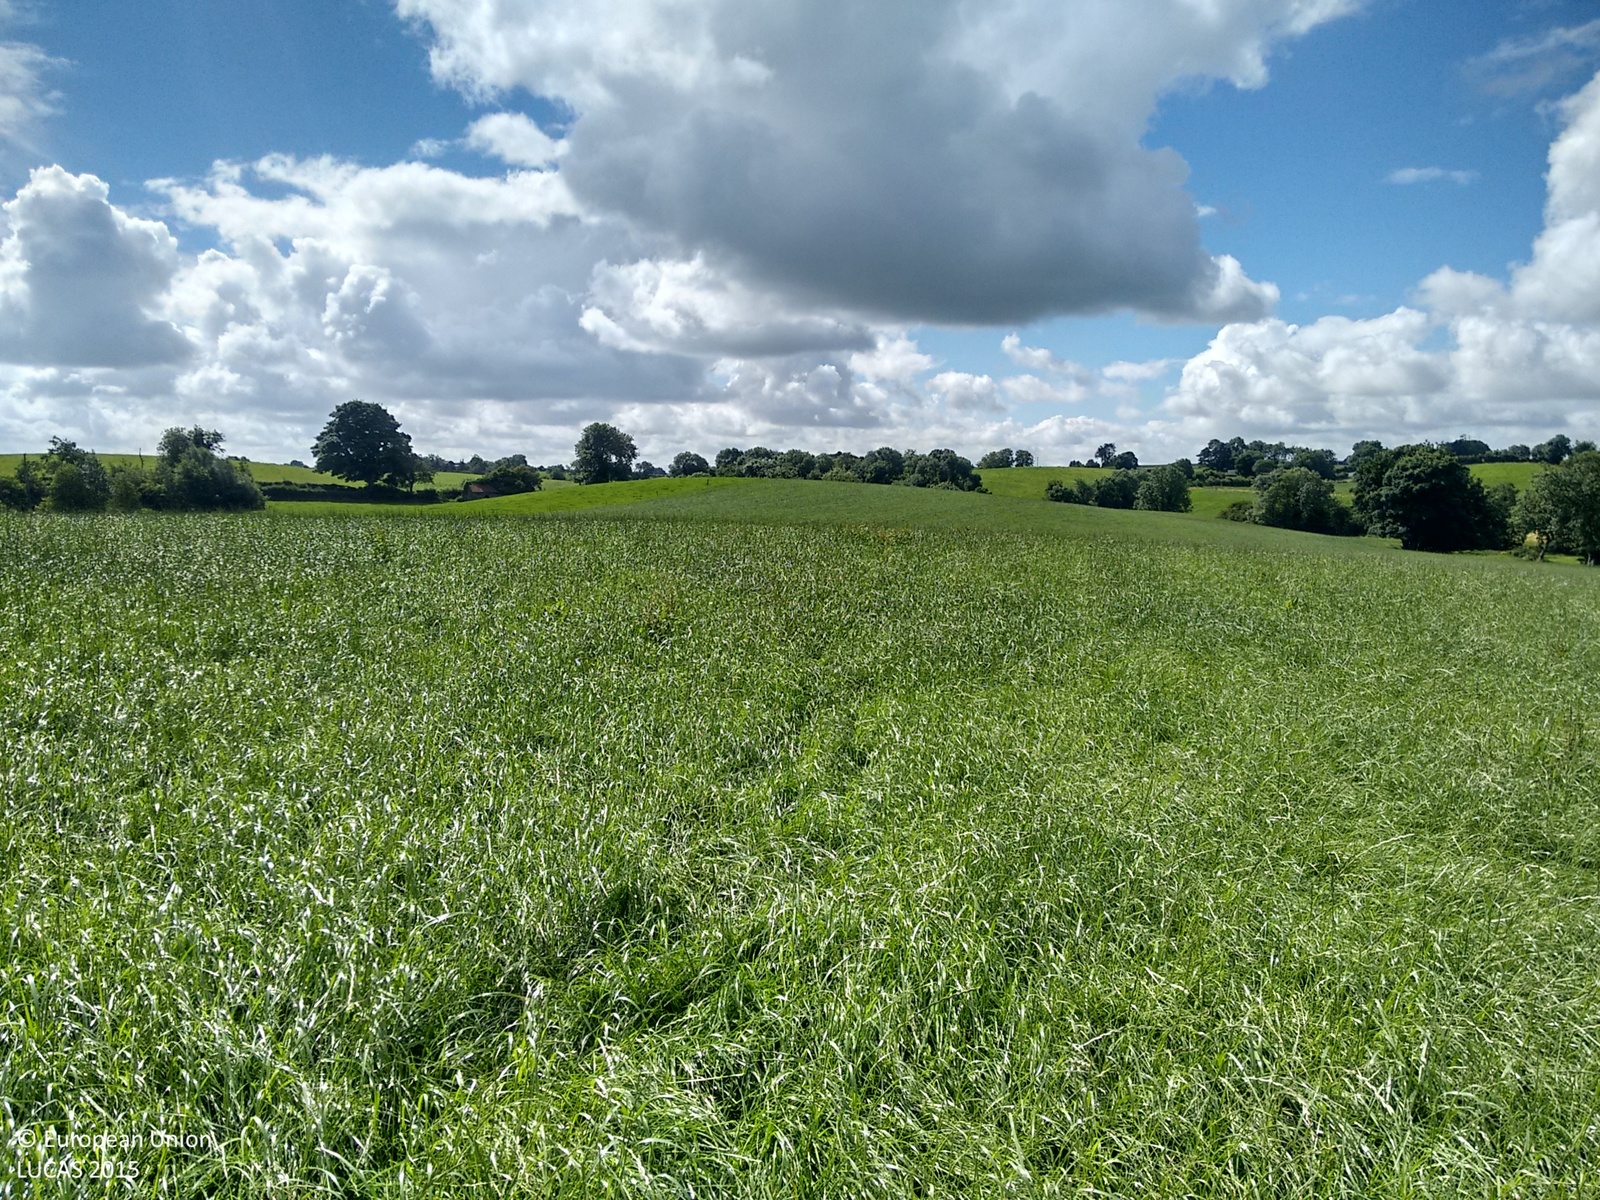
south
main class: Cropland
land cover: Temporary grasslands
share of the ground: > 75 %
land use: Agriculture (excluding fallow land and kitchen gardens)
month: August
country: IE
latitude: 54.0400
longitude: -6.5109
